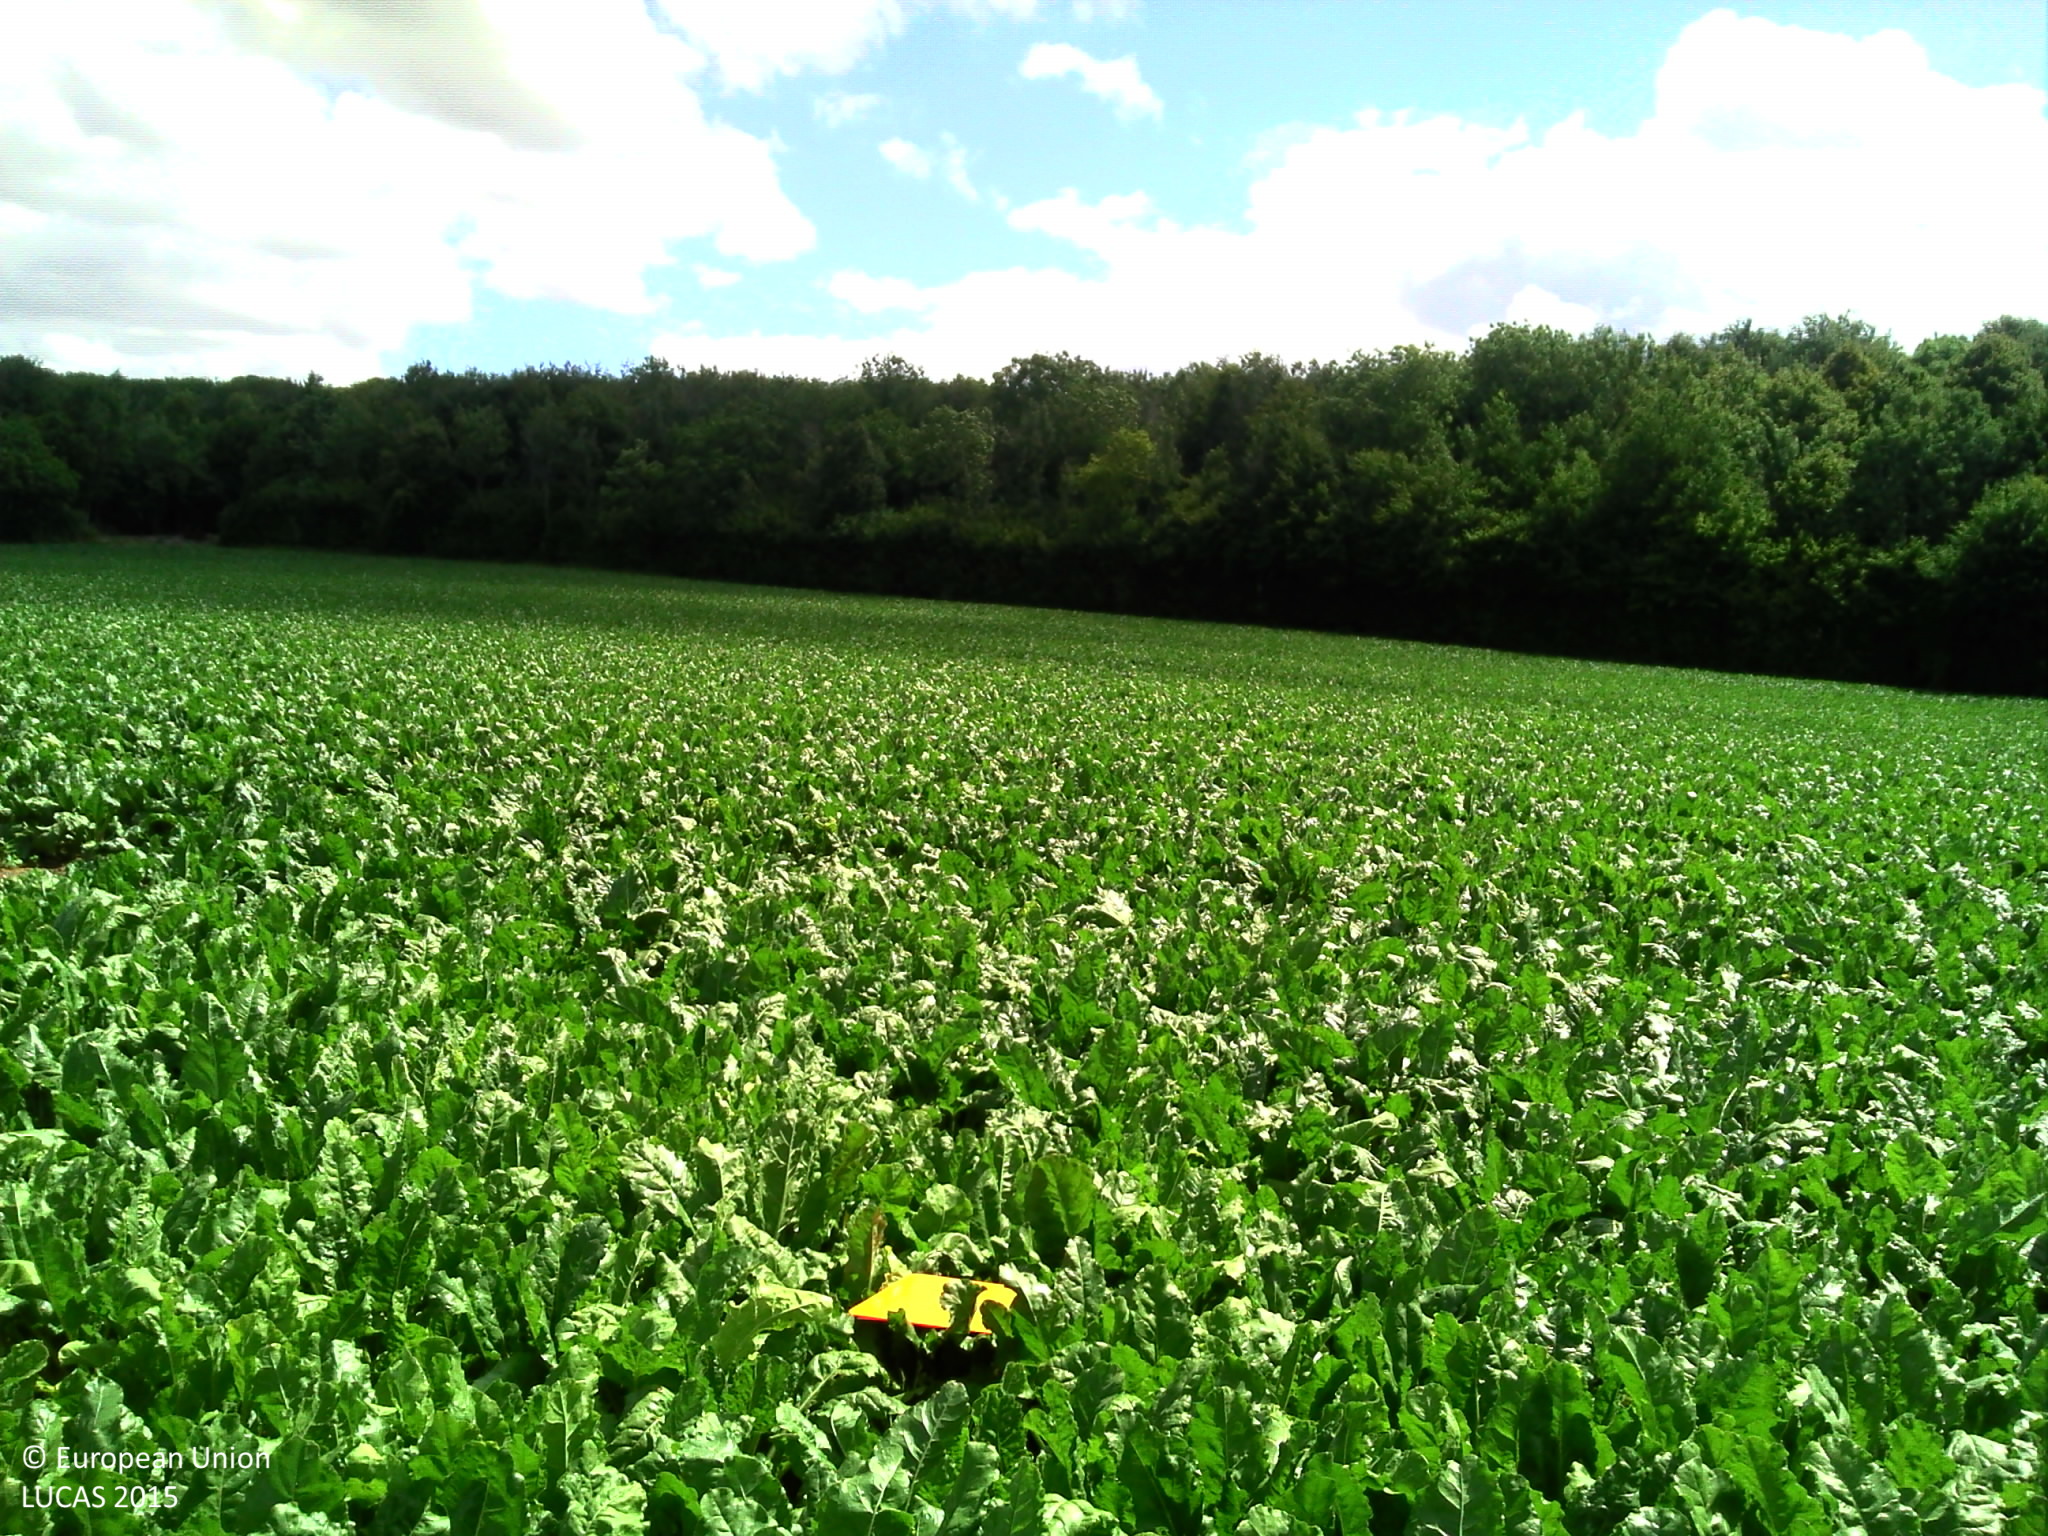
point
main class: Cropland
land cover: Sugar beet
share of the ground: > 75 %
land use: Agriculture (excluding fallow land and kitchen gardens)
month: July
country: FR
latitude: 50.0052
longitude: 2.4389
